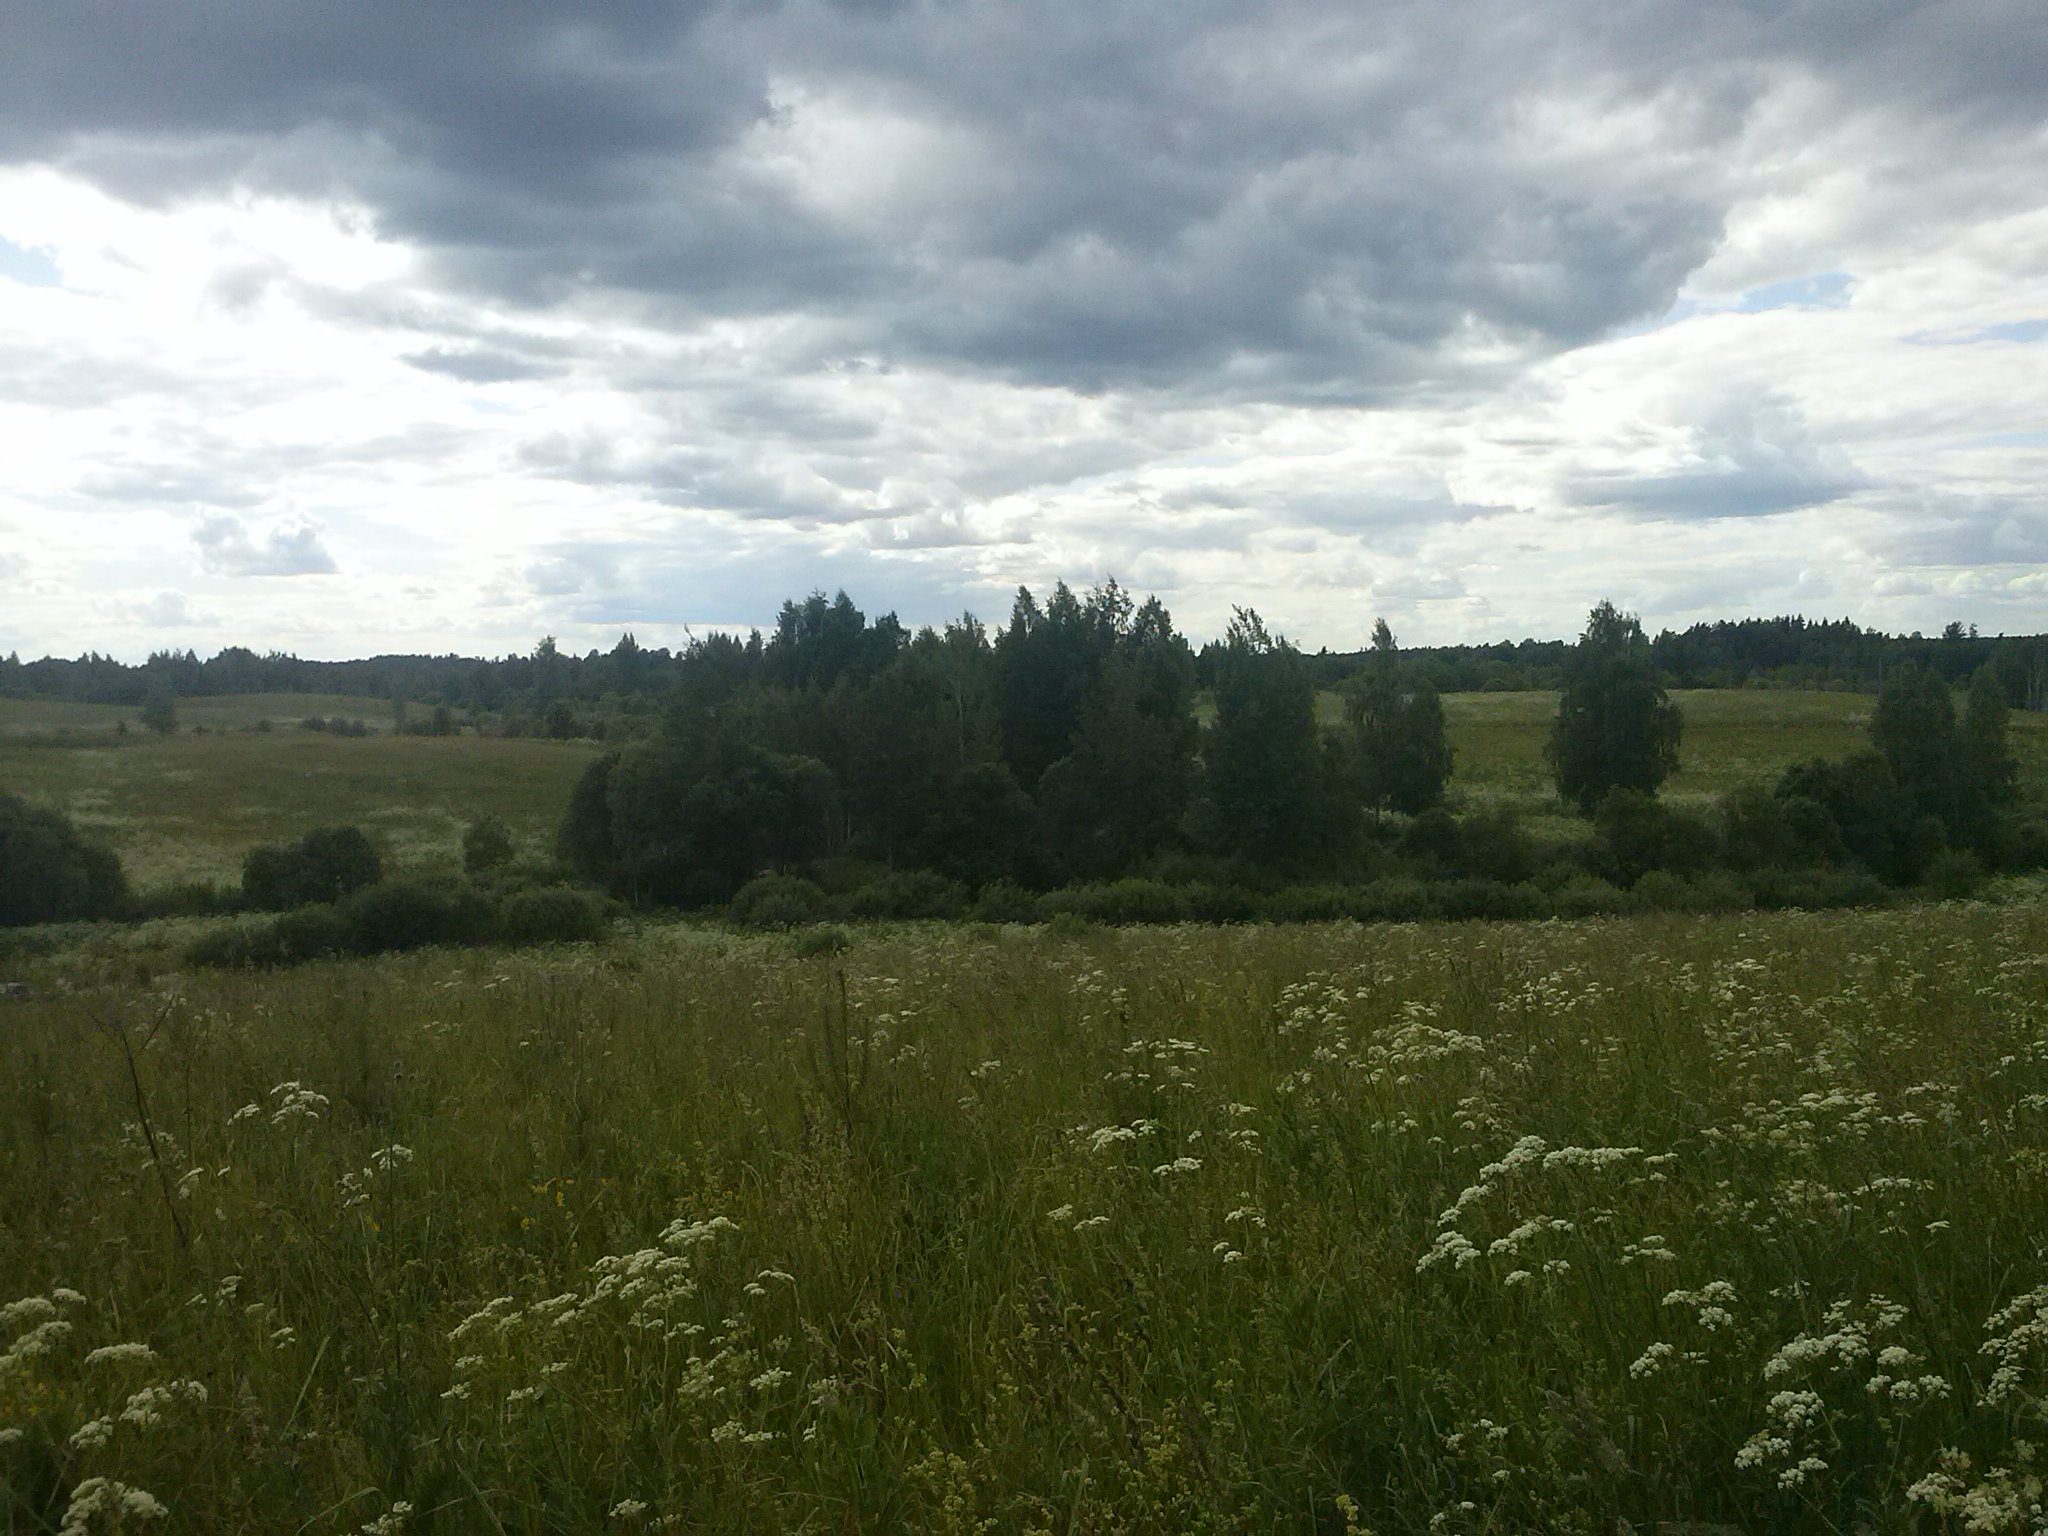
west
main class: Grassland
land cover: Grassland with sparse tree/shrub cover
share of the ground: > 75 %
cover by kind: herbaceous plants 85 %, shrubs 10 %, coniferous forest trees 5 %
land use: Semi-natural and natural areas not in use
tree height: < 5 m
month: June
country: LV
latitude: 56.4696
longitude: 27.8690
